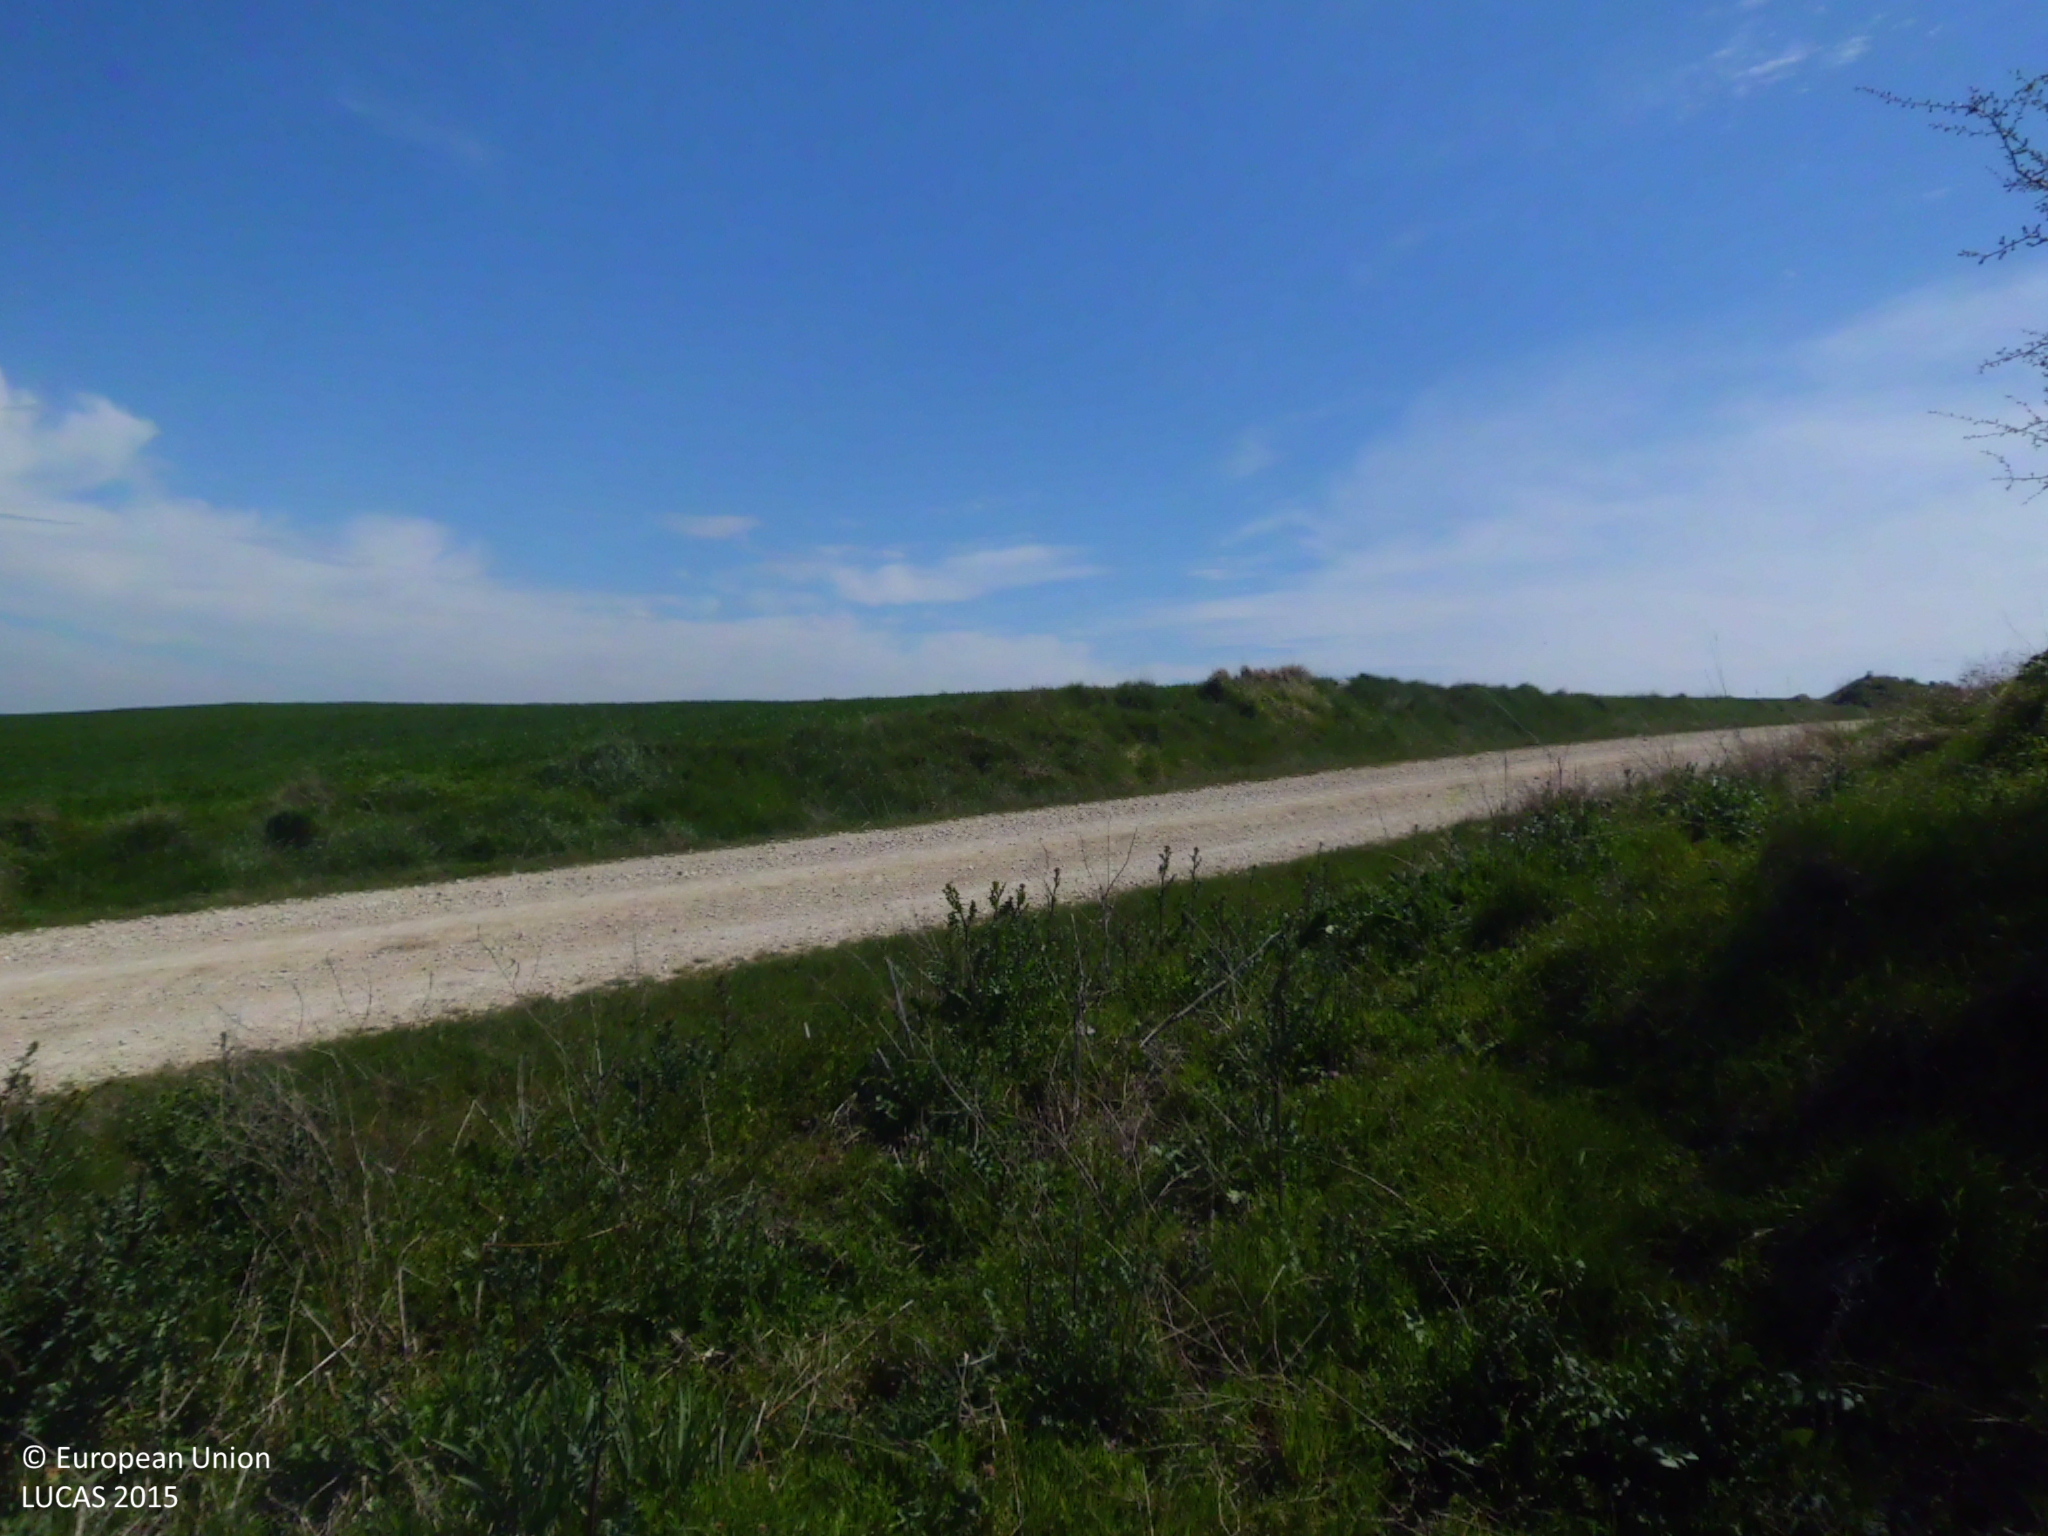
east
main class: Grassland
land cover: Grassland with sparse tree/shrub cover
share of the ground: > 75 %
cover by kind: herbaceous plants 90 %, broadleaved forest trees 5 %, shrubs 5 %
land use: Abandoned areas
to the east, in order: Grassland with sparse tree/shrub cover; Tracks; Grass margins; Common wheat; Tracks; Barley
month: April
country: ES
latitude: 42.4639
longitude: -3.3245
